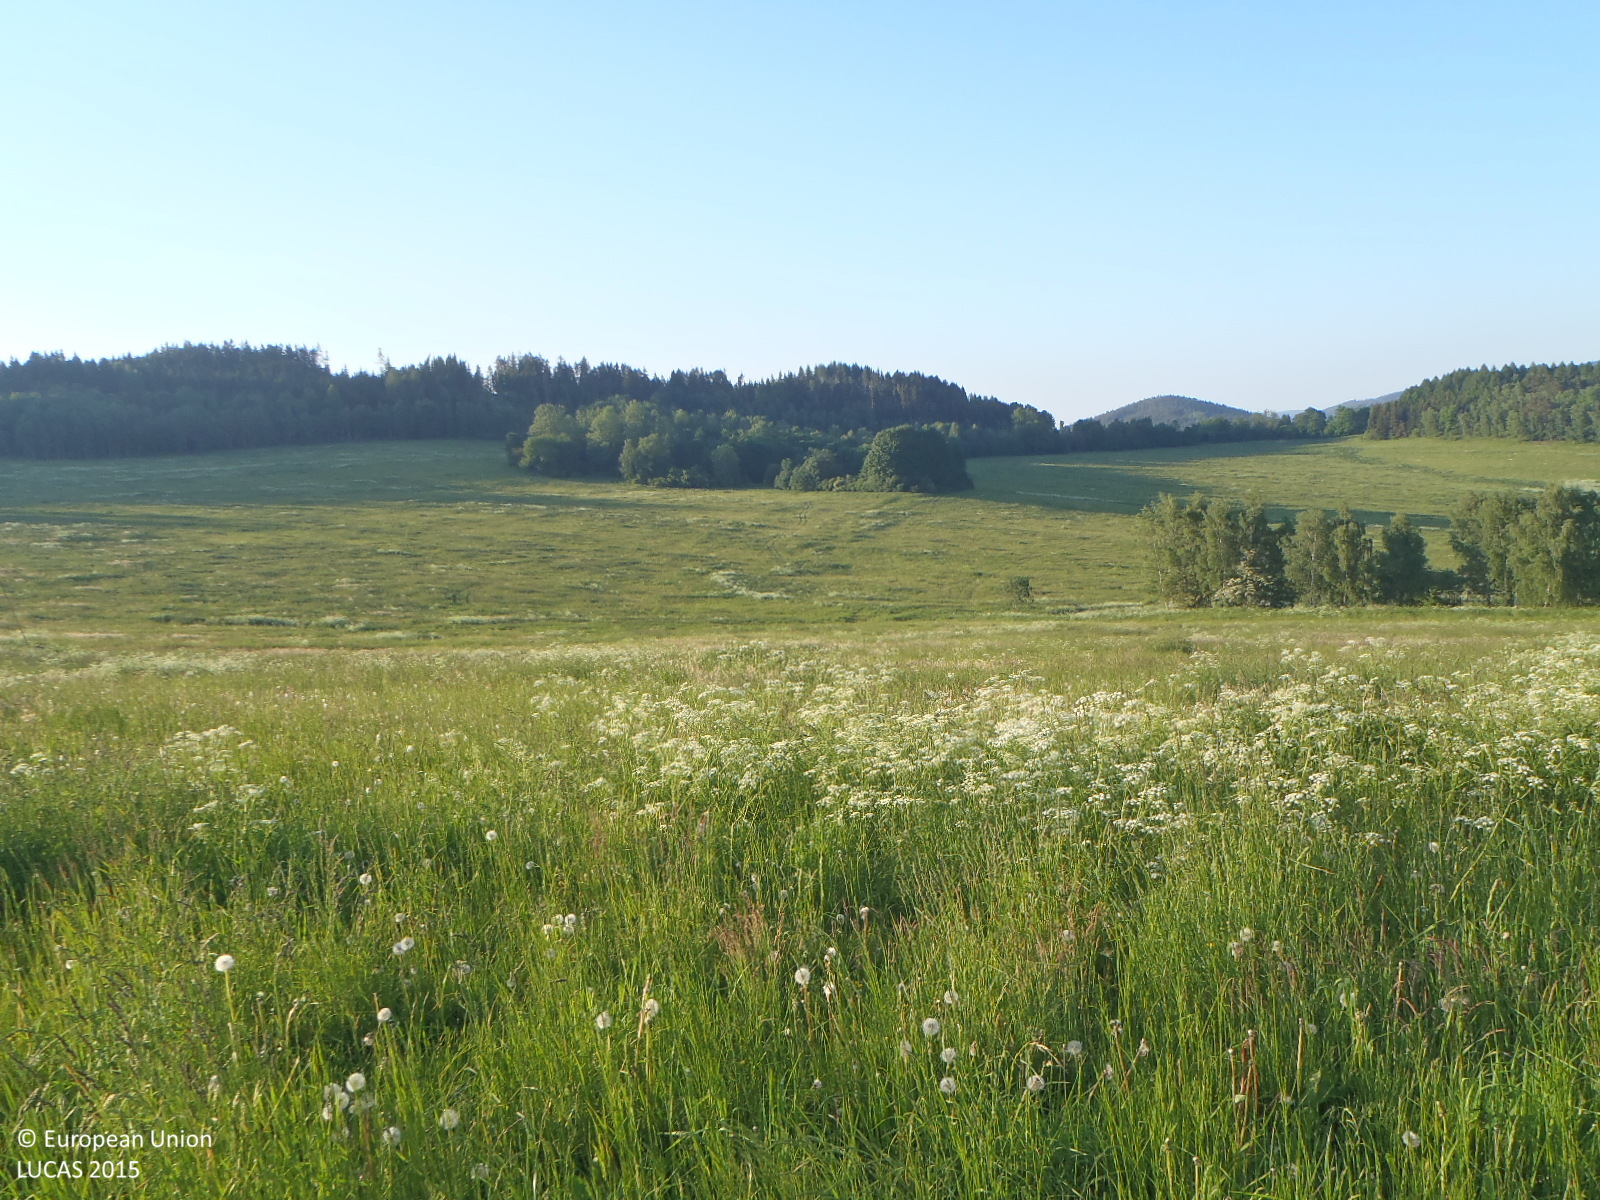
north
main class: Grassland
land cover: Grassland without tree/shrub cover
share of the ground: > 75 %
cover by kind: herbaceous plants 100 %
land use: Agriculture (excluding fallow land and kitchen gardens)
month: June
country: CZ
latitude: 48.6431
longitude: 14.3300
